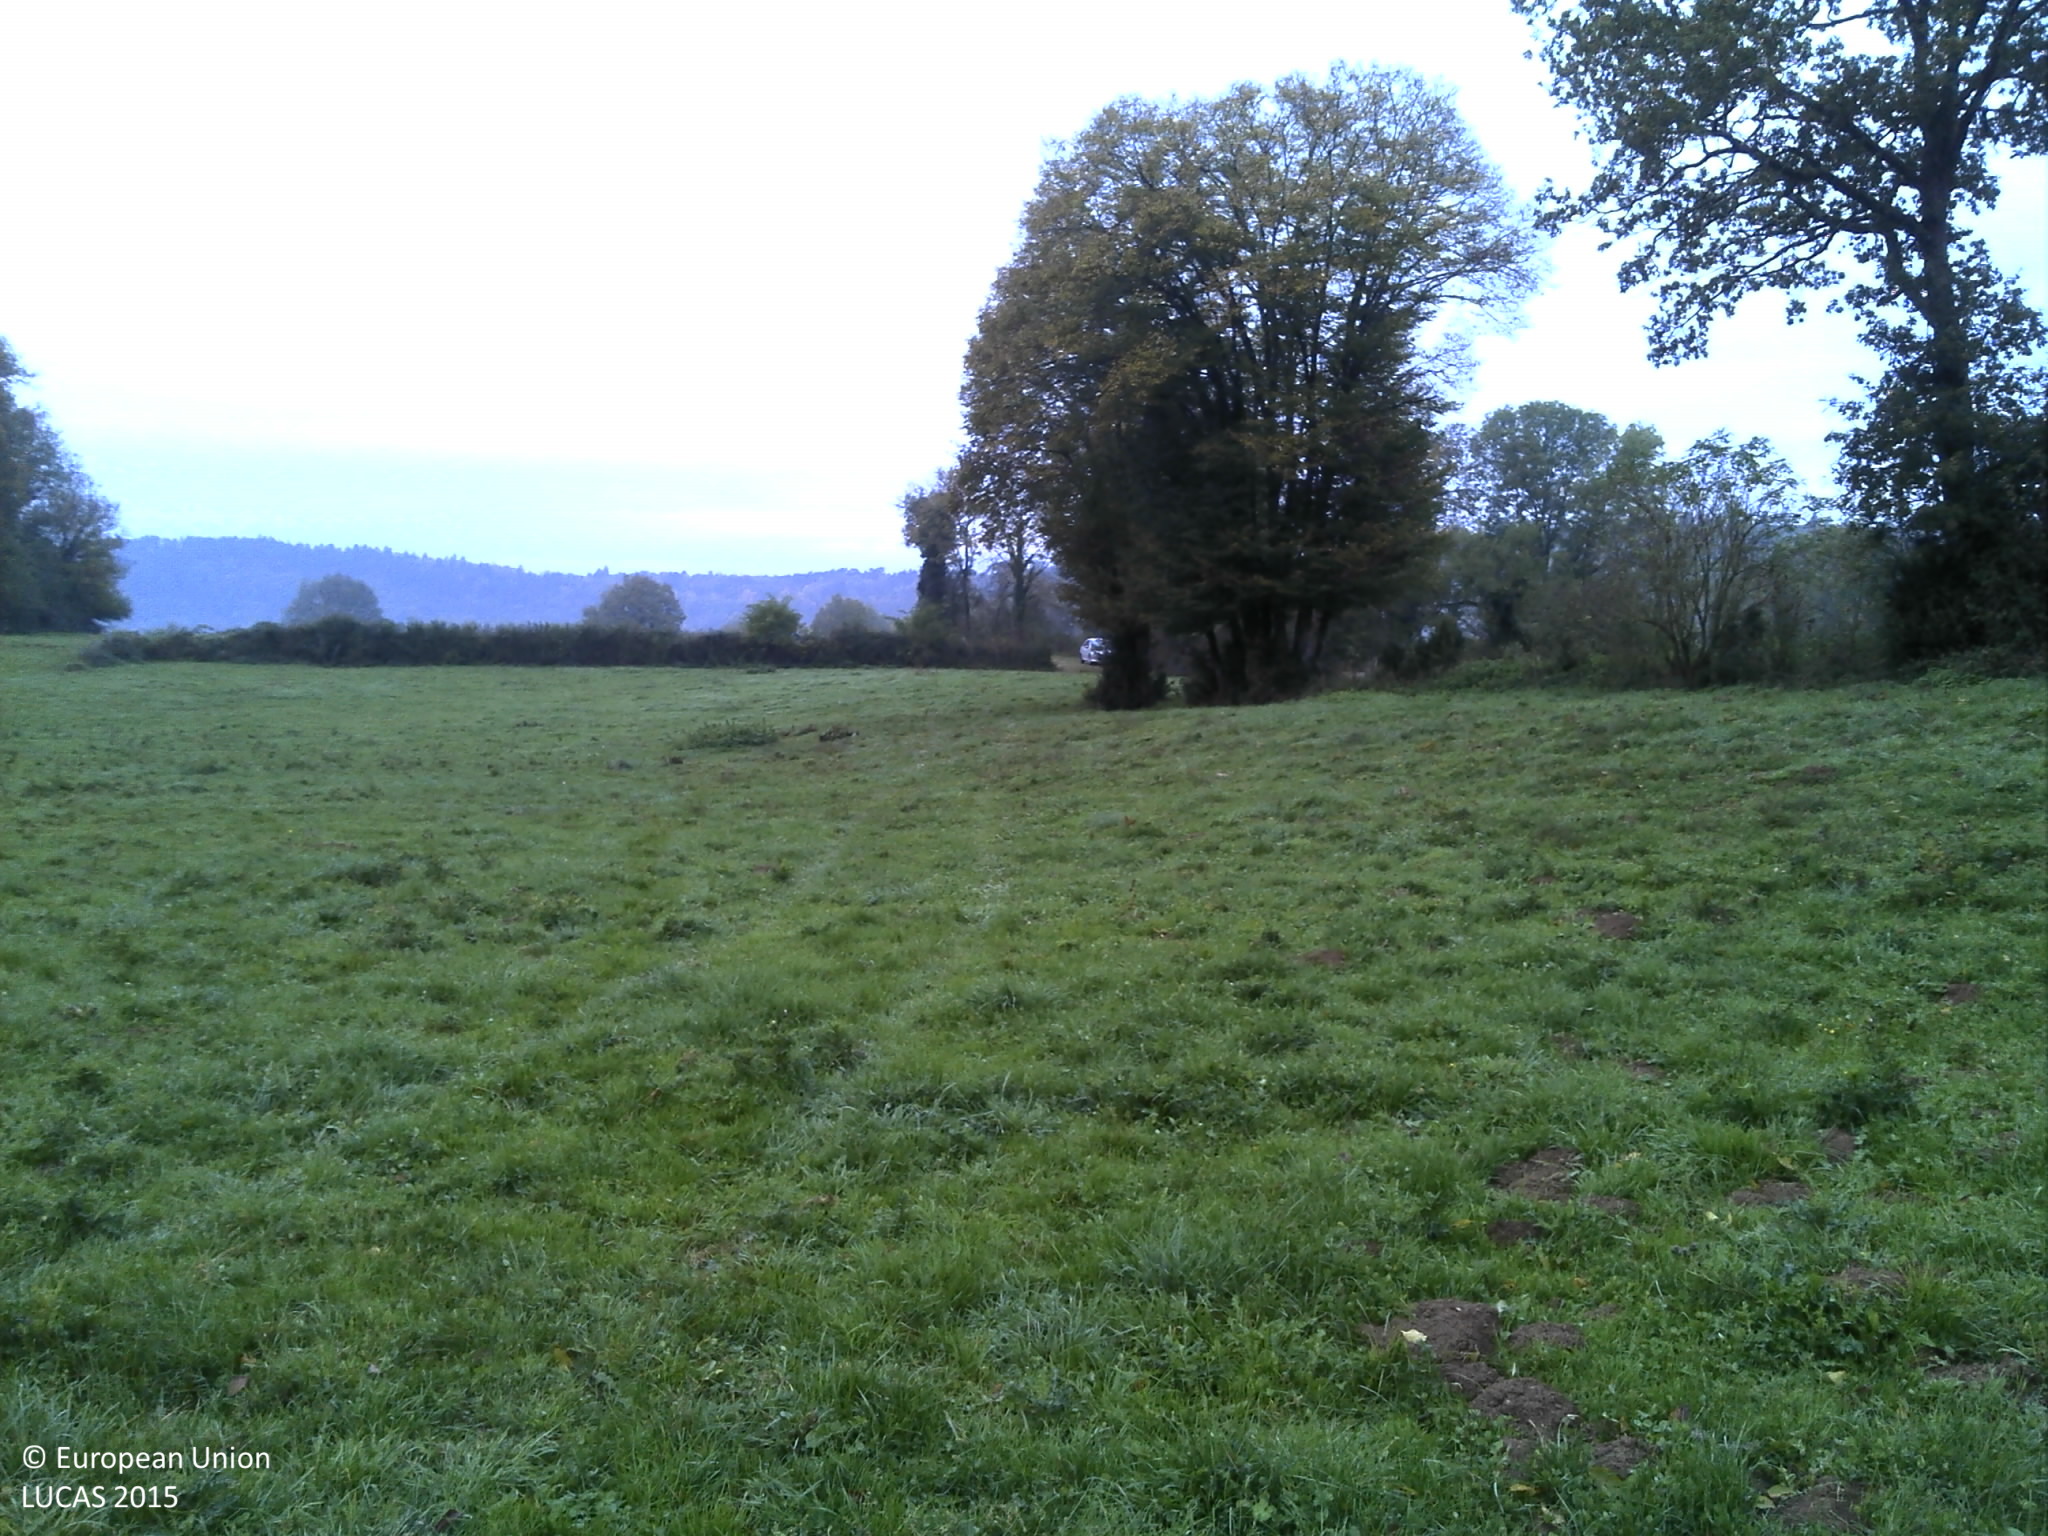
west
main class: Grassland
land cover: Grassland without tree/shrub cover
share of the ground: > 75 %
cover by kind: herbaceous plants 100 %
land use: Agriculture (excluding fallow land and kitchen gardens)
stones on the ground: < 10 %
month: October
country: FR
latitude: 46.2151
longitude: 5.3754
